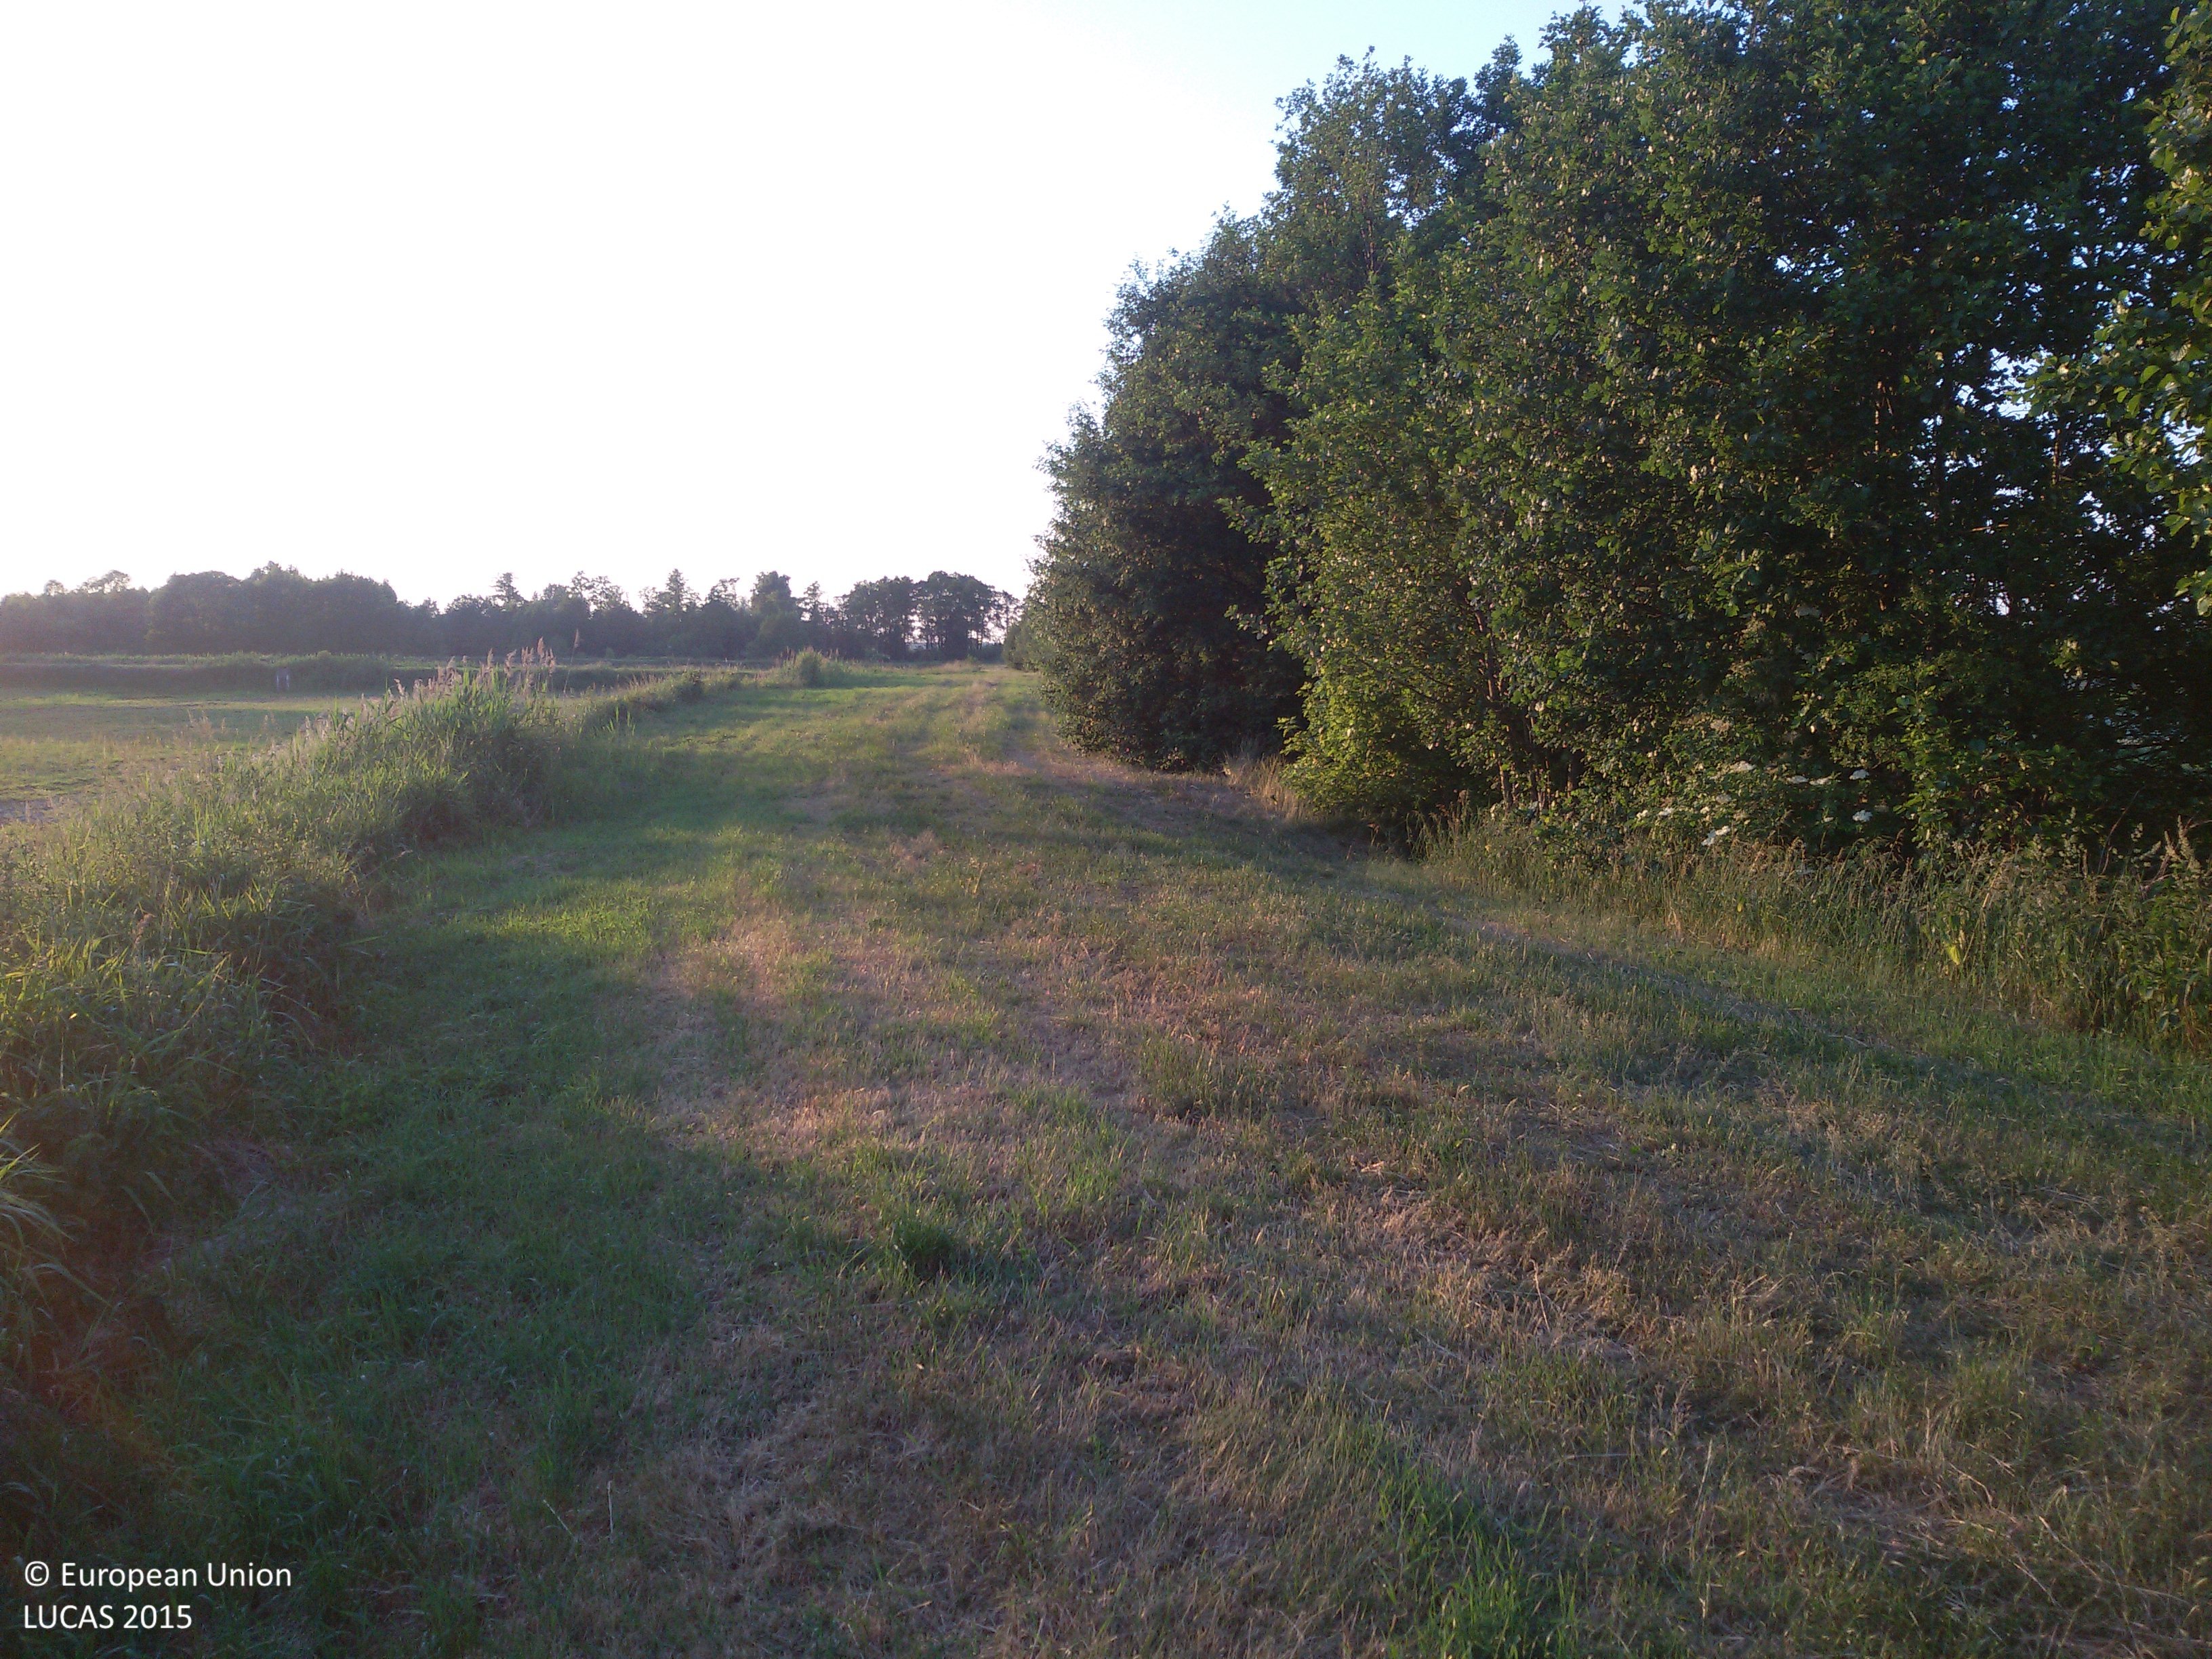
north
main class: Grassland
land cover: Grassland without tree/shrub cover
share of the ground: > 75 %
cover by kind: herbaceous plants 100 %
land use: Agriculture (excluding fallow land and kitchen gardens)
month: June
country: PL
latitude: 52.0173
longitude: 19.8966
